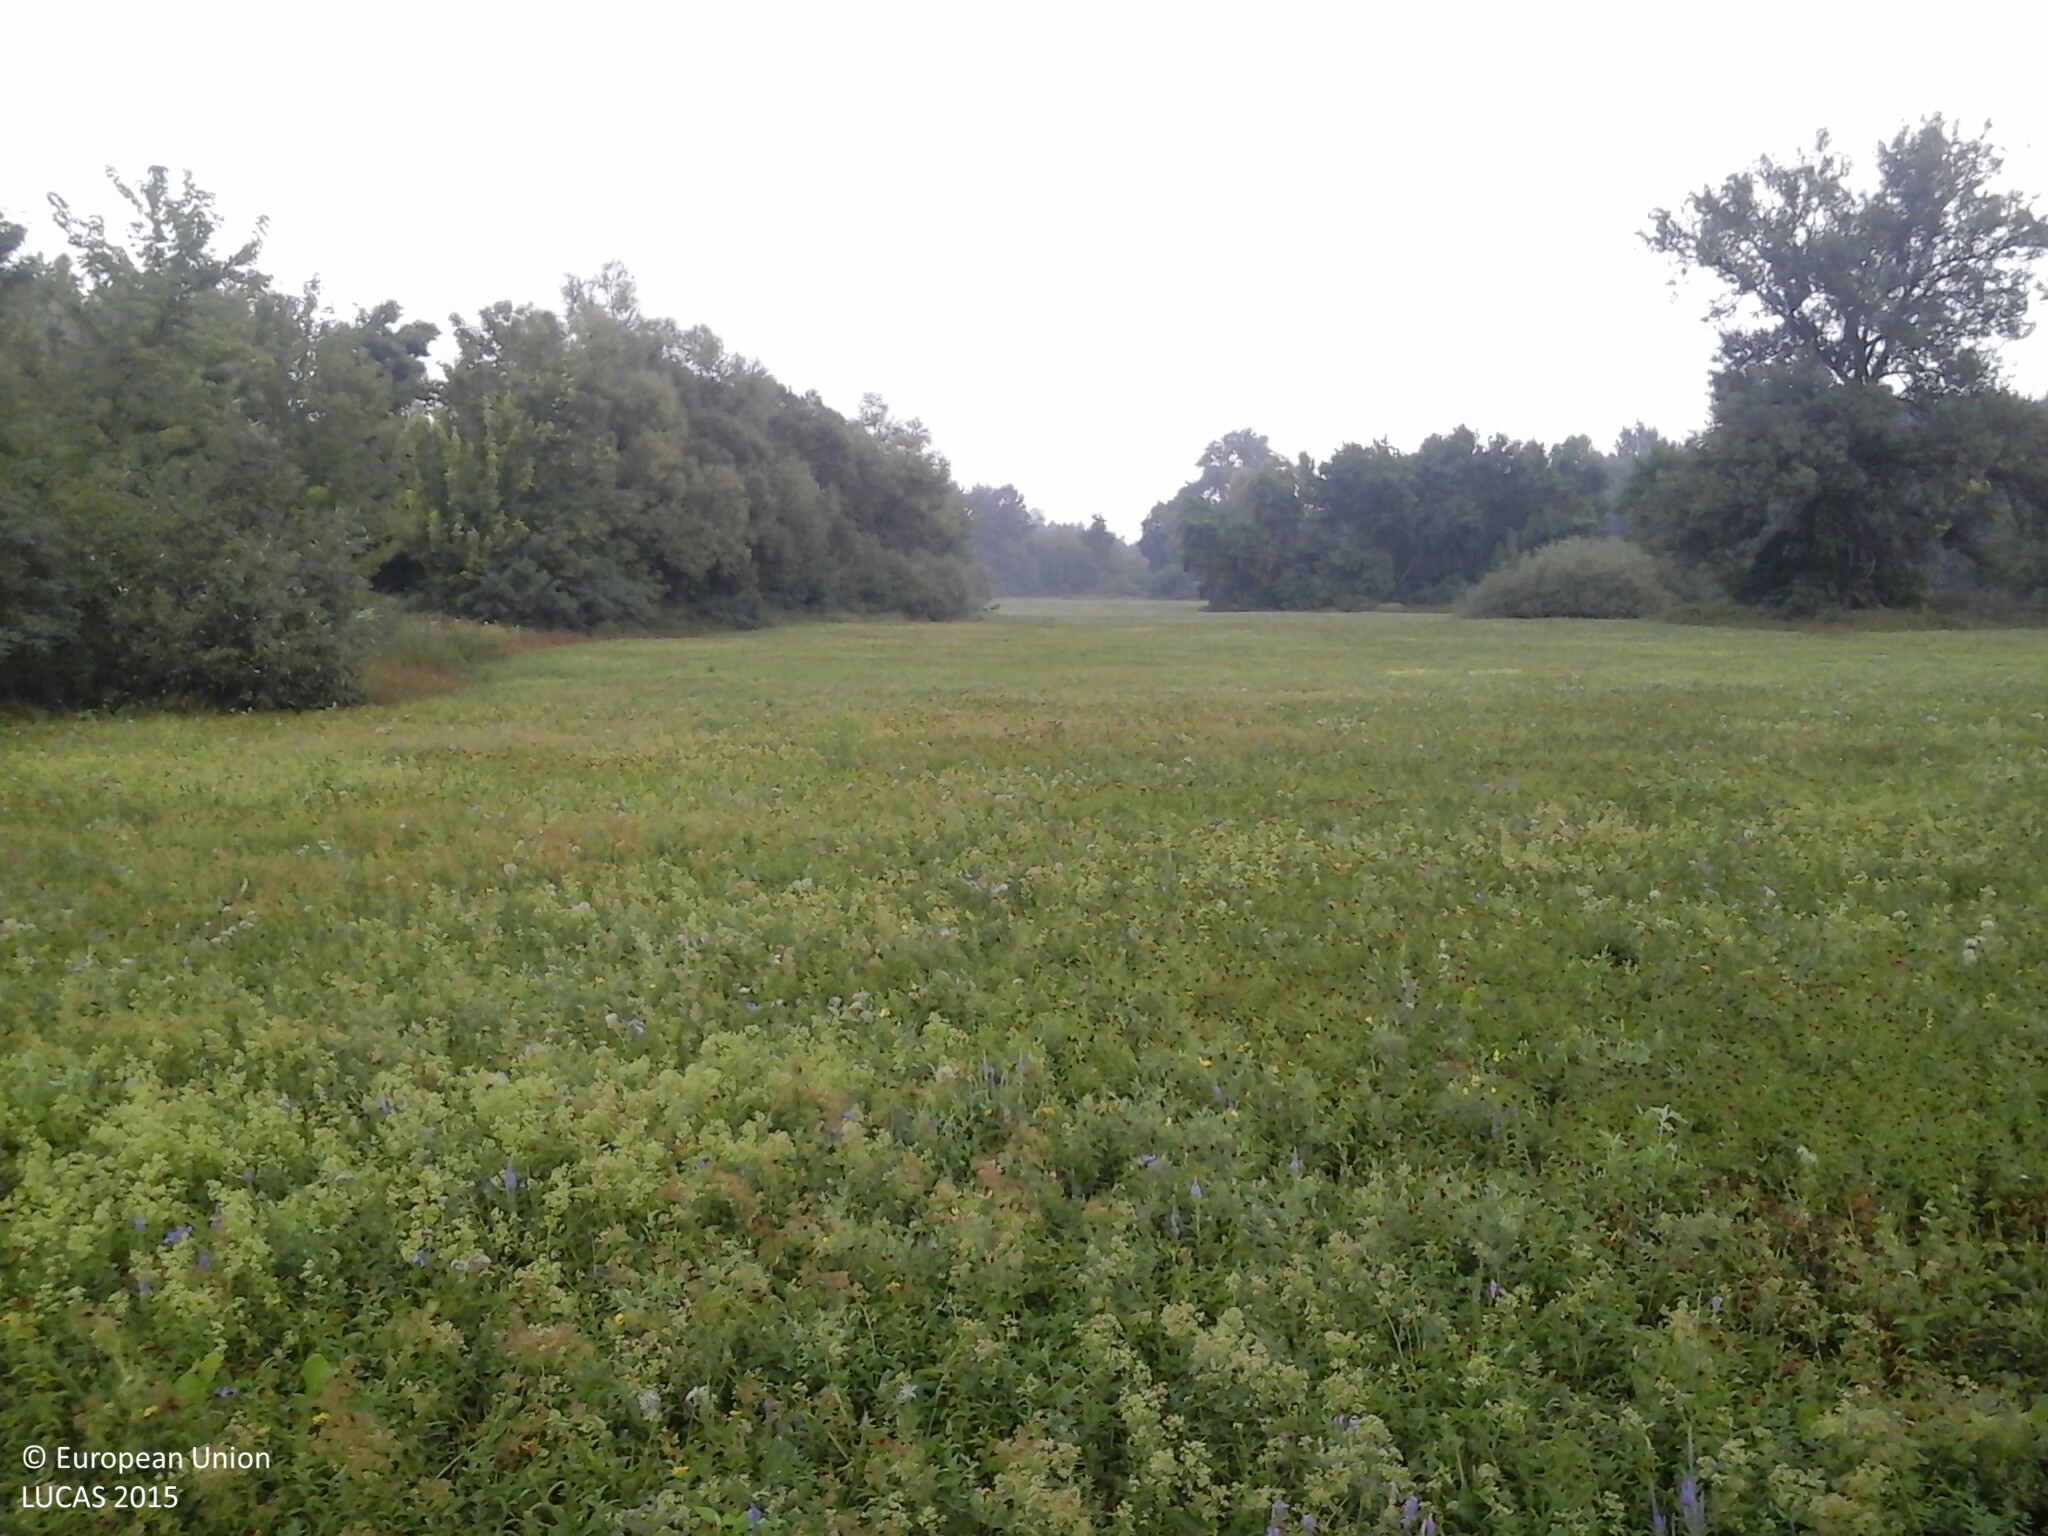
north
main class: Grassland
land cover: Grassland with sparse tree/shrub cover
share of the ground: > 75 %
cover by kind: herbaceous plants 85 %, shrubs 10 %, broadleaved forest trees 5 %
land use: Agriculture (excluding fallow land and kitchen gardens)
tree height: > 5 m
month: August
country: HU
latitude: 47.9353
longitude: 21.0829
